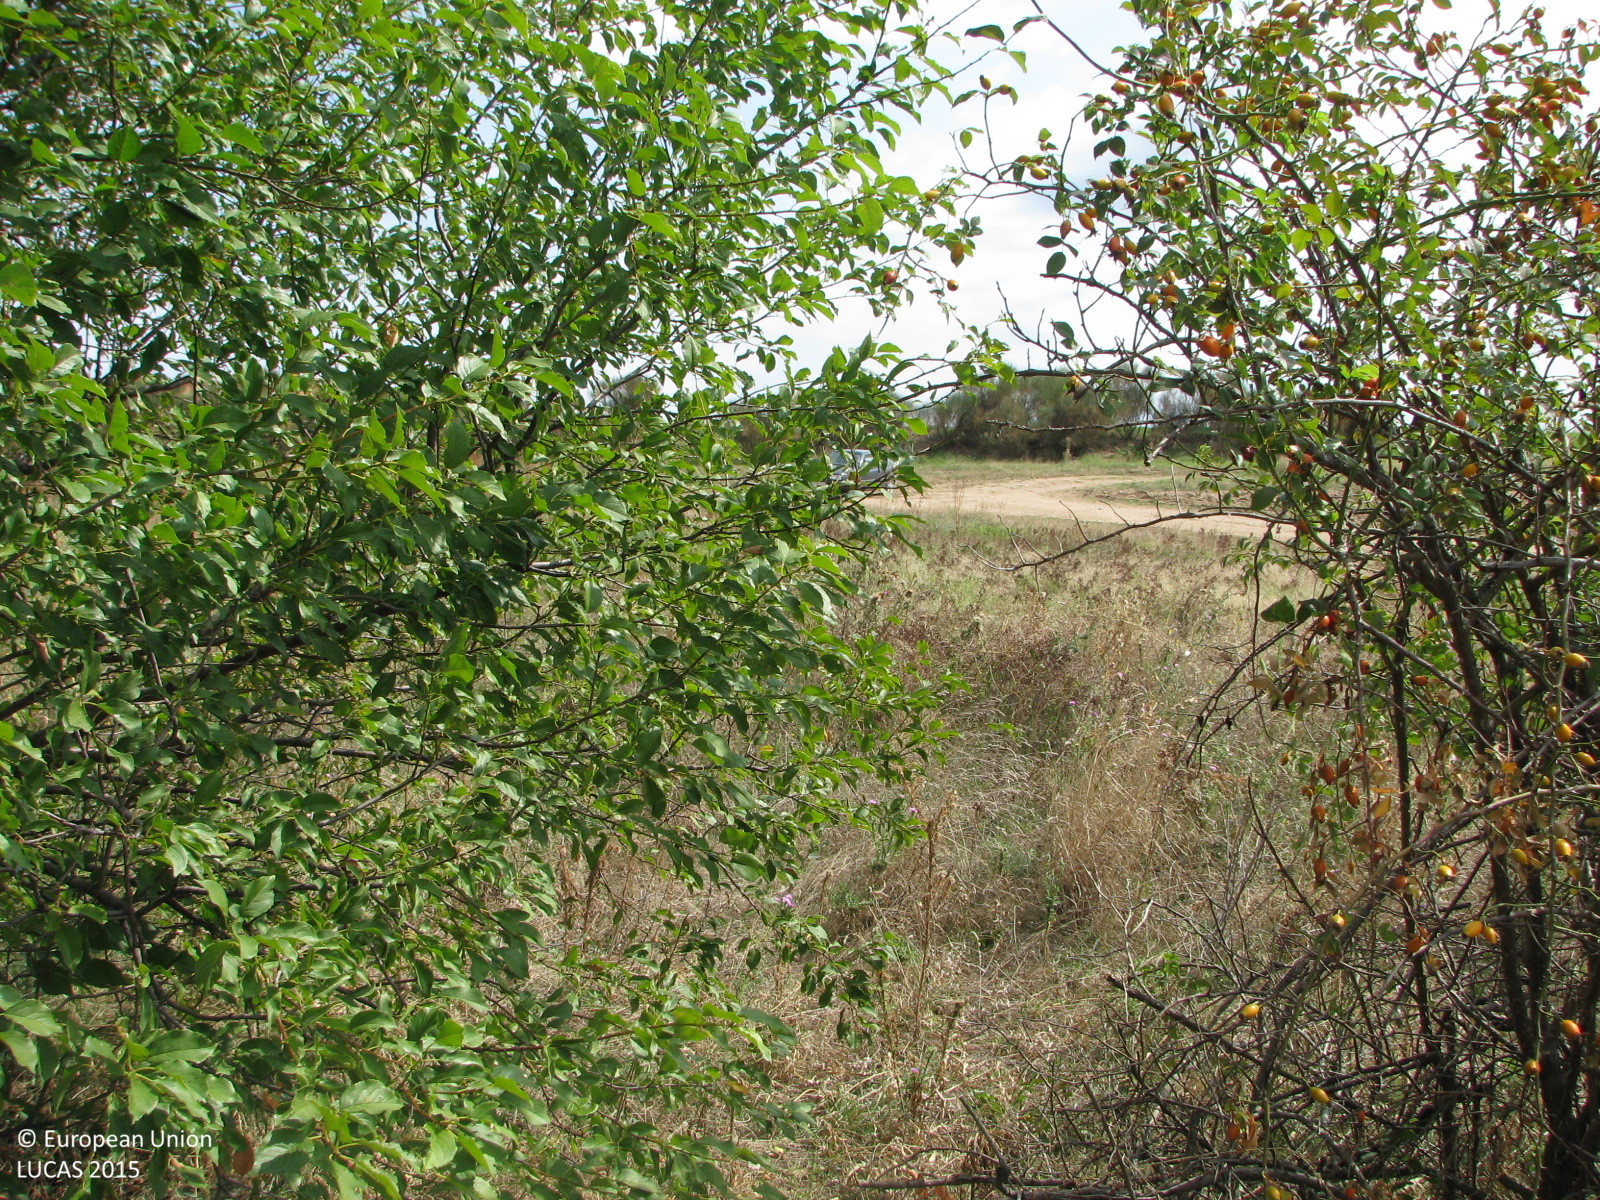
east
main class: Grassland
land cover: Grassland with sparse tree/shrub cover
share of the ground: > 75 %
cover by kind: herbaceous plants 90 %, broadleaved forest trees 5 %, shrubs 5 %
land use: Semi-natural and natural areas not in use
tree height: < 5 m
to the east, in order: Grassland with sparse tree/shrub cover; Tracks; Other bare soil; Grassland without tree/shrub cover; Tracks; Grassland without tree/shrub cover; Lines of trees; Grass margins; Paved roads, cycling and walking lanes; Grass margins; Ditches and canals; Grass margins; Other bare soil; Grassland without tree/shrub cover; Inland fresh water bodies; Spontaneously vegetated surfaces; Inland fresh water bodies; Grassland without tree/shrub cover; Electric lines; Grassland without tree/shrub cover; Tracks
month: September
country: BG
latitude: 42.4102
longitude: 26.0598
